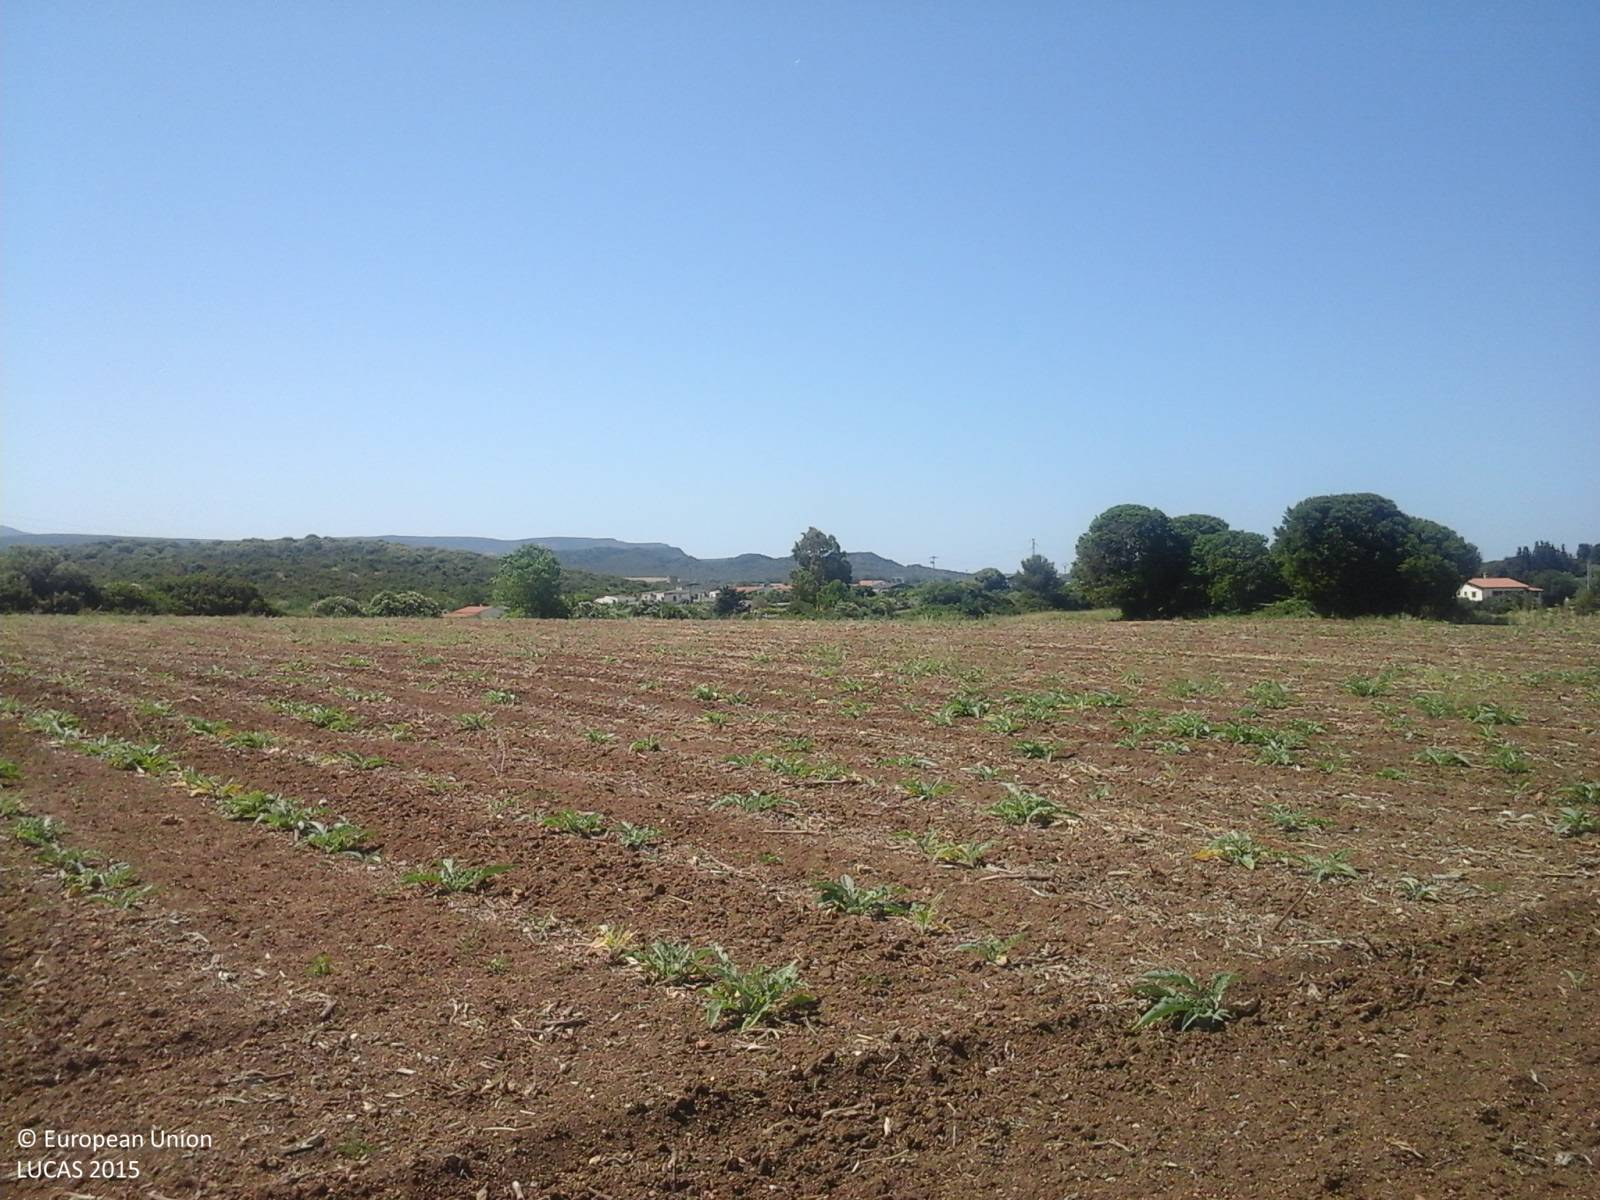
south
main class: Cropland
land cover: Other fresh vegetables
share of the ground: < 10 %
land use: Agriculture (excluding fallow land and kitchen gardens)
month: June
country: IT
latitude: 40.6161
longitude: 8.3885
